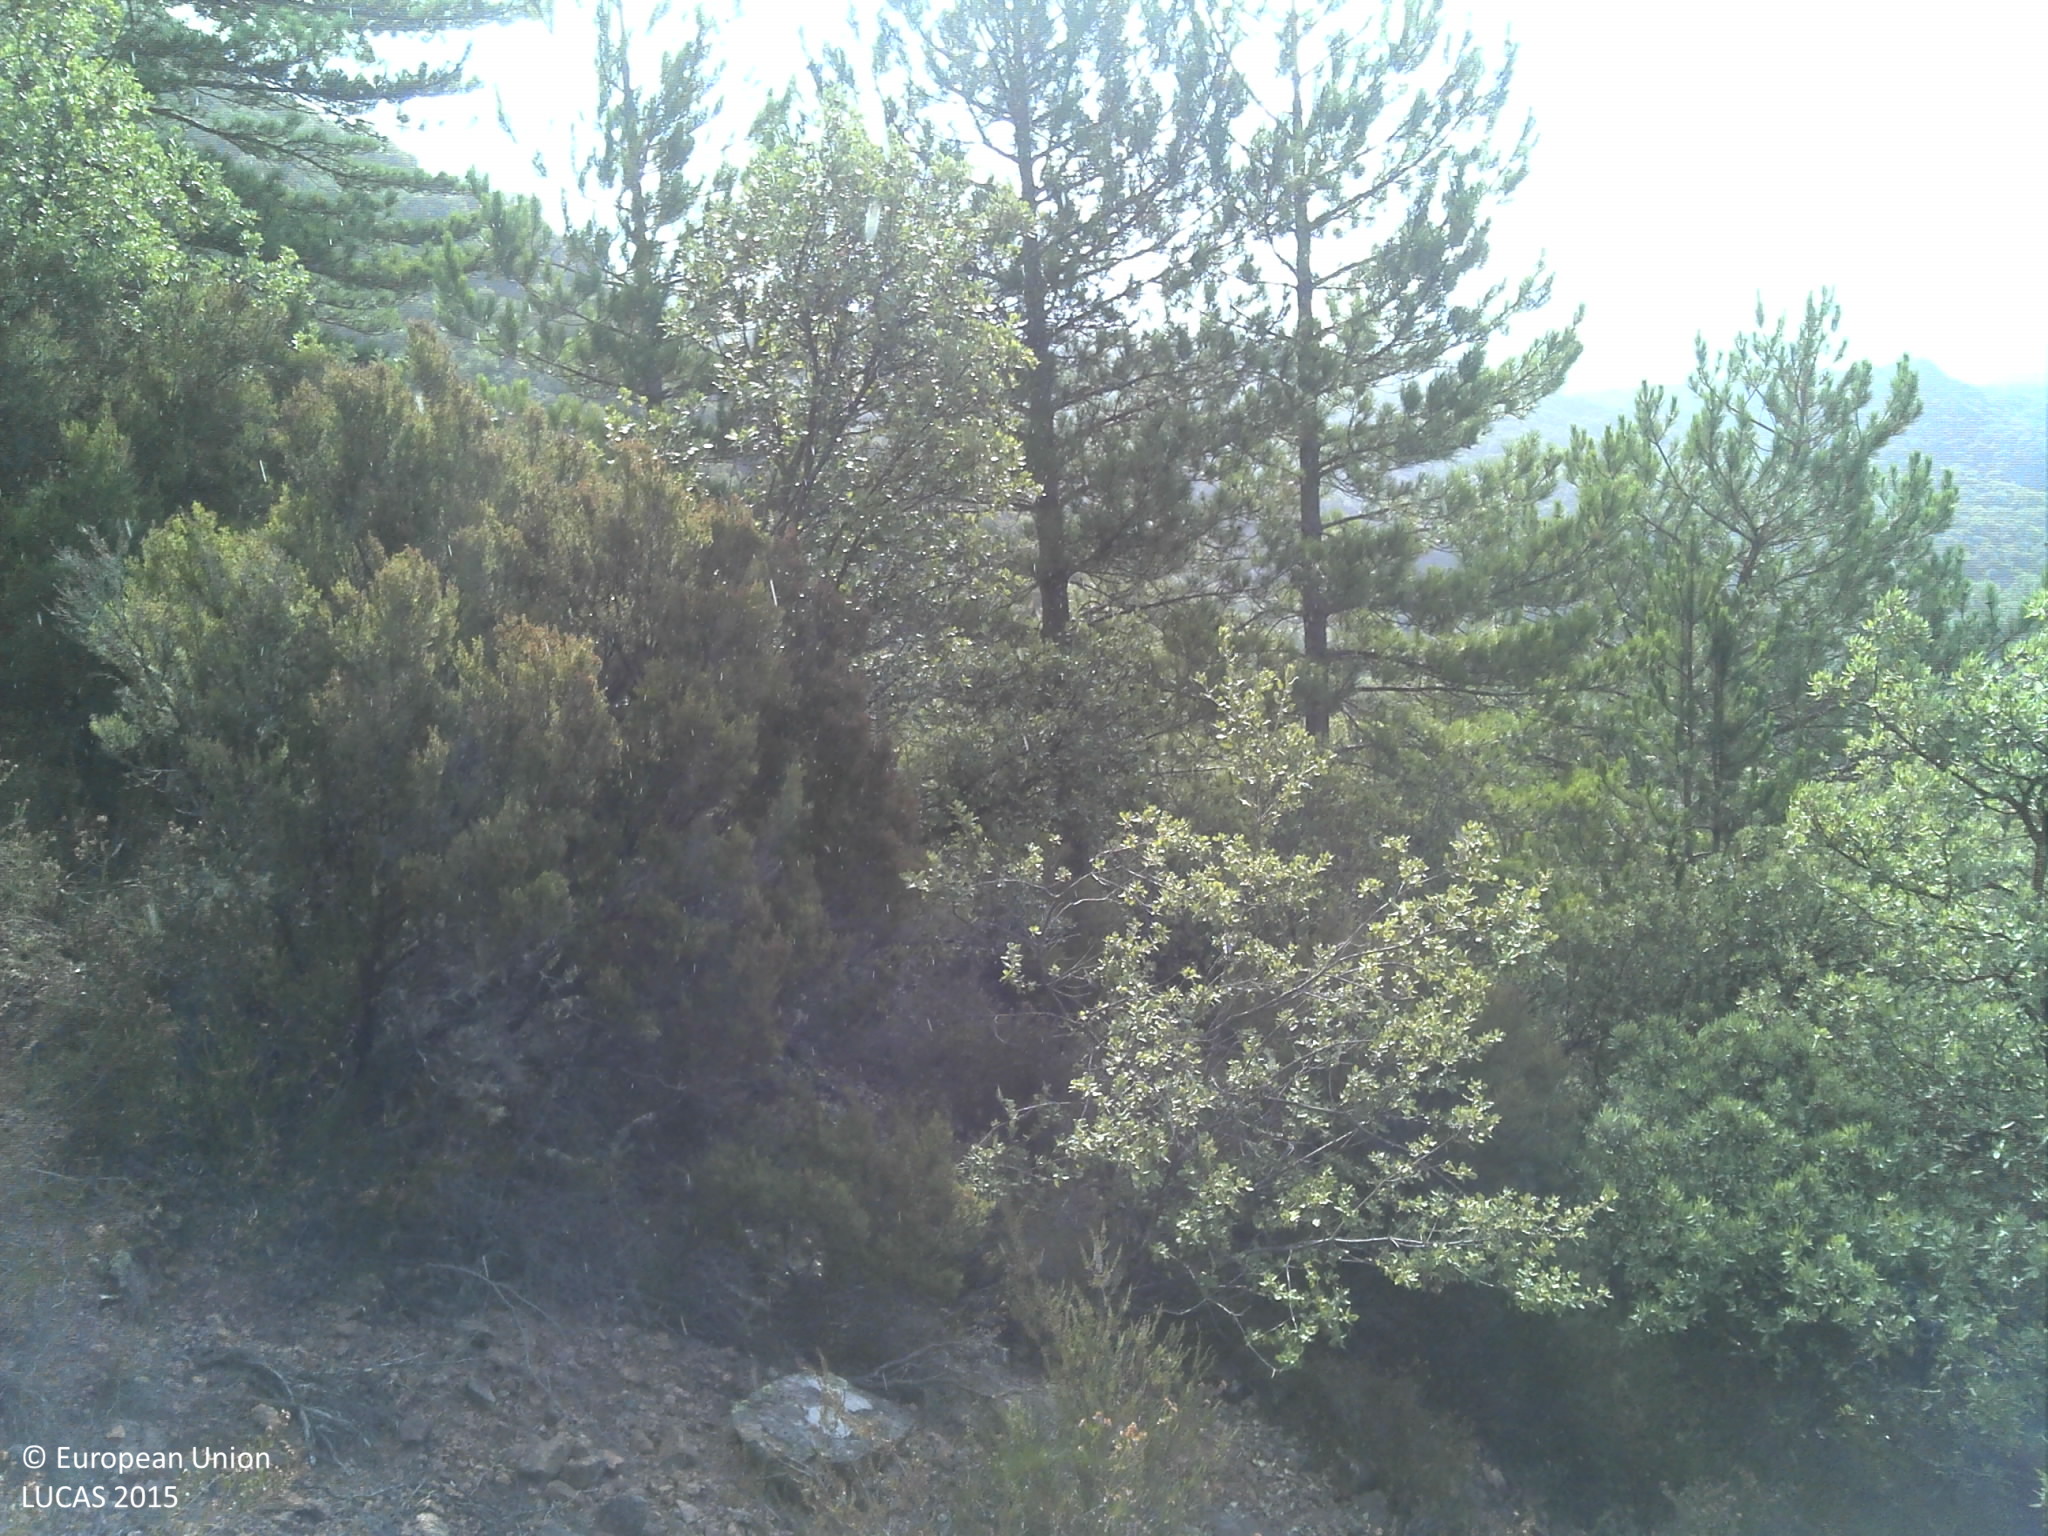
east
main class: Shrubland
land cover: Shrubland with sparse tree cover
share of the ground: > 75 %
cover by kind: shrubs 70 %, consolidated bare surface 25 %, broadleaved forest trees 5 %
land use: Semi-natural and natural areas not in use
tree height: < 5 m
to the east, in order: Shrubland with sparse tree cover; Pine dominated mixed woodland; Rocks and stones; Broadleaved woodland; Inland fresh running water; Broadleaved woodland; Other bare soil; Broadleaved woodland
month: July
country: FR
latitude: 43.7254
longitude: 3.1428
